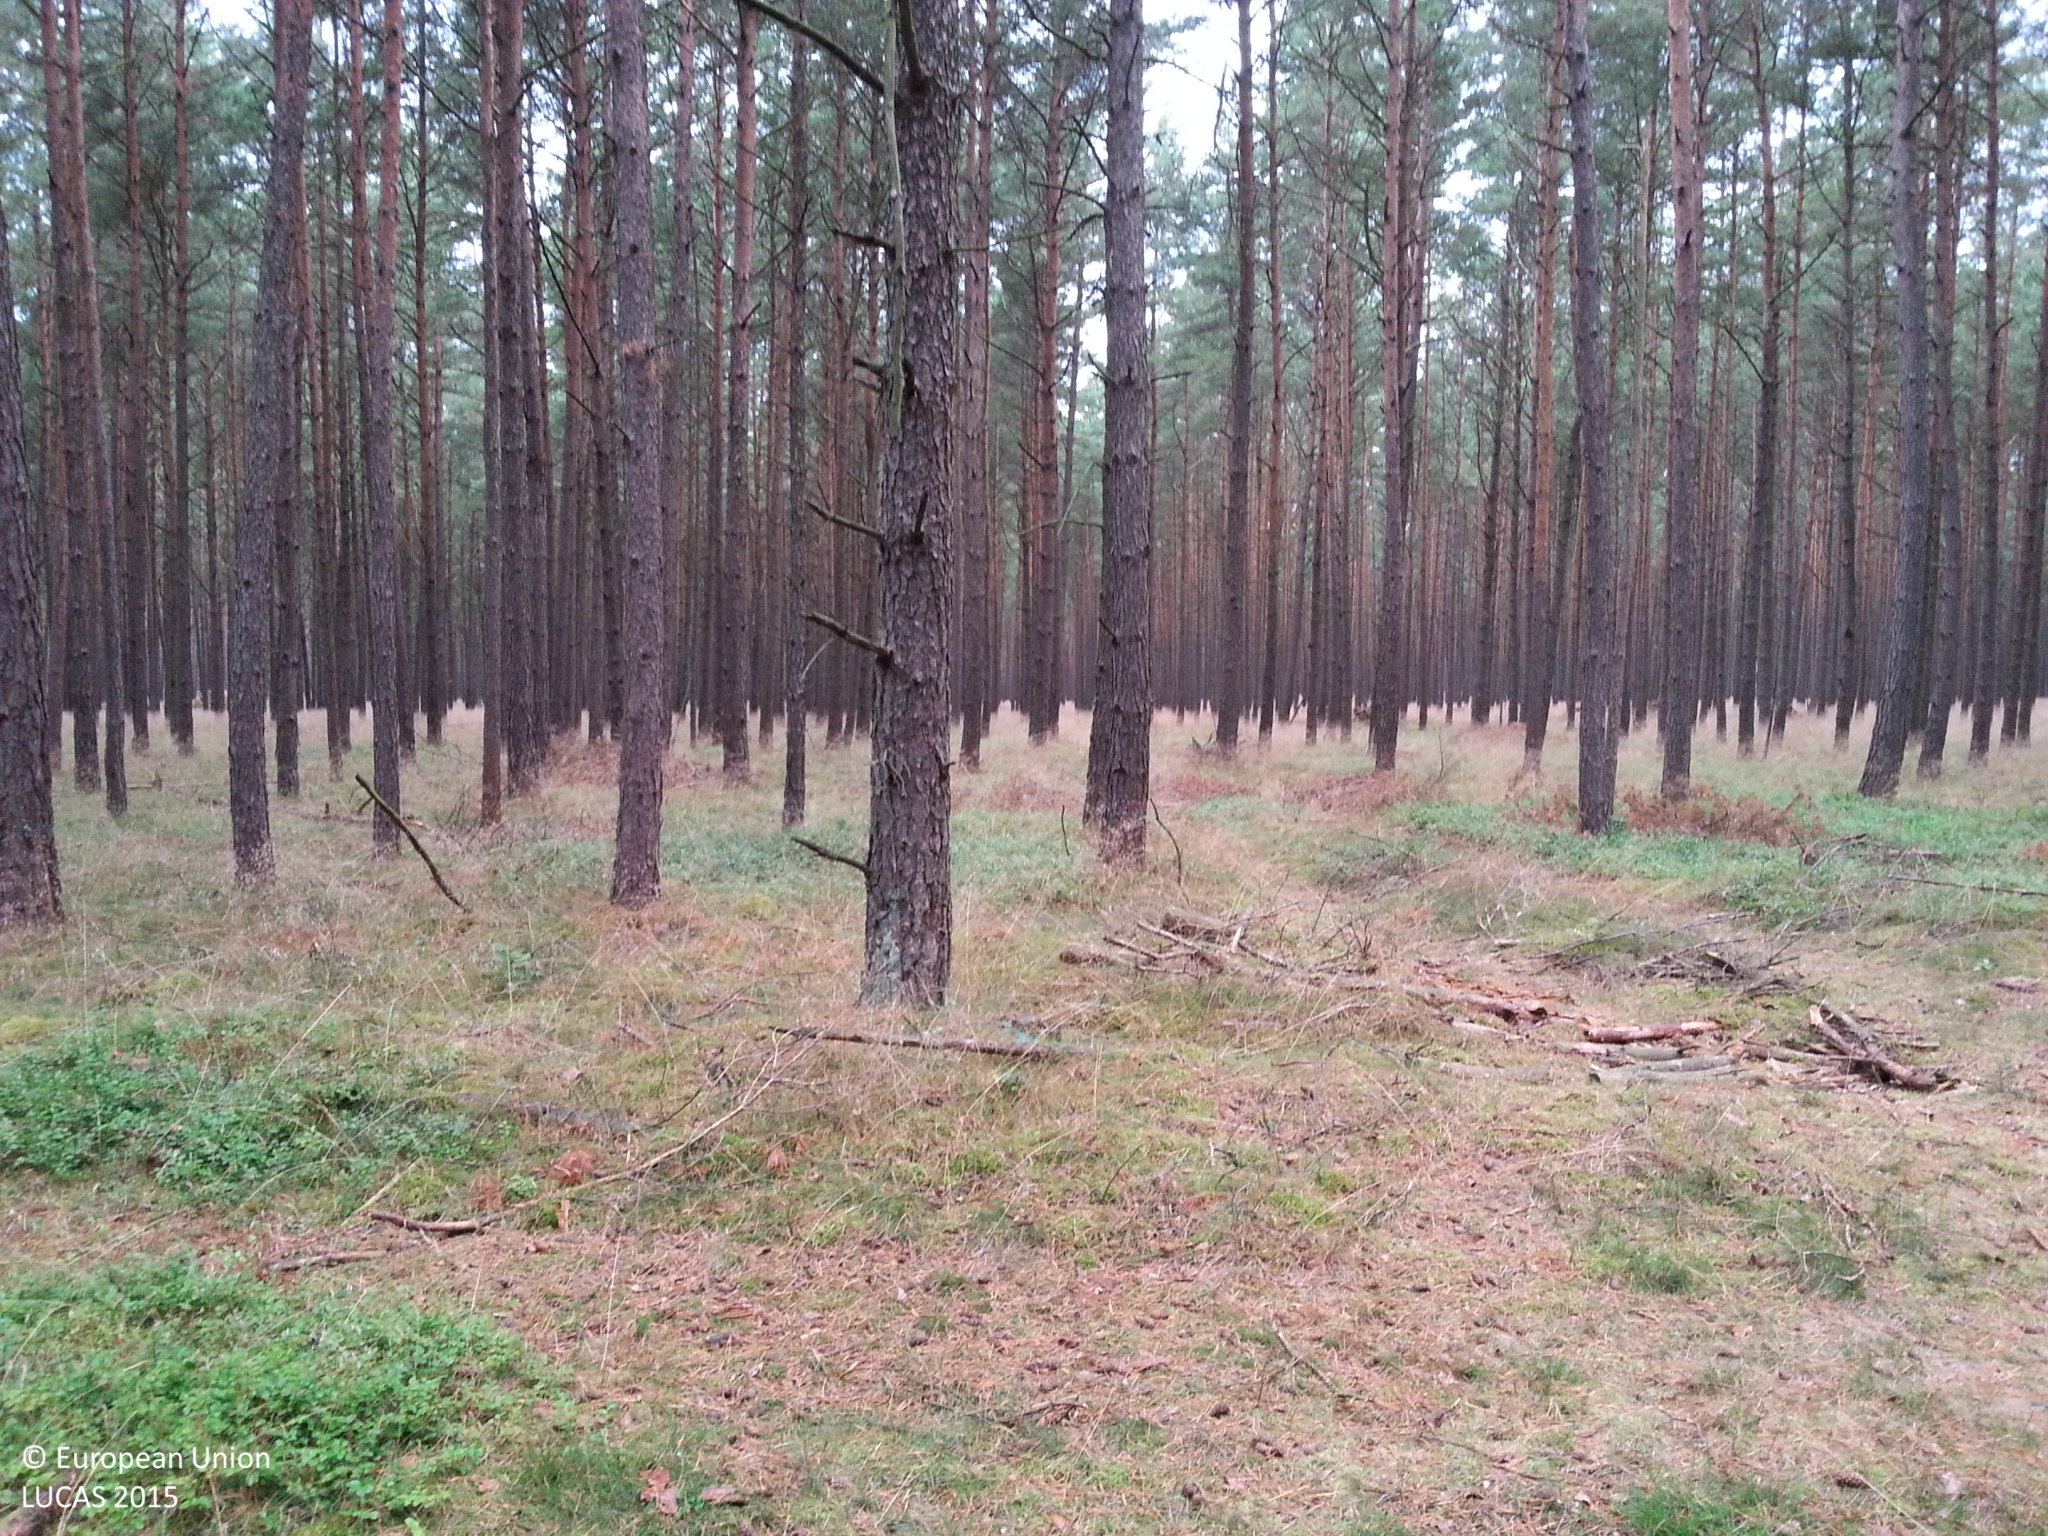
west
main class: Woodland
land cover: Pine dominated coniferous woodland
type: hemiboreal forest and nemoral coniferous forest and mixed broadleaved-coniferous forest
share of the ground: 50 - 75 %
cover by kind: coniferous forest trees 50 %, herbaceous plants 35 %, lichens and mosses 15 %
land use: Forestry
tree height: > 5 m
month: July
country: DE
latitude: 53.1095
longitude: 12.3447
